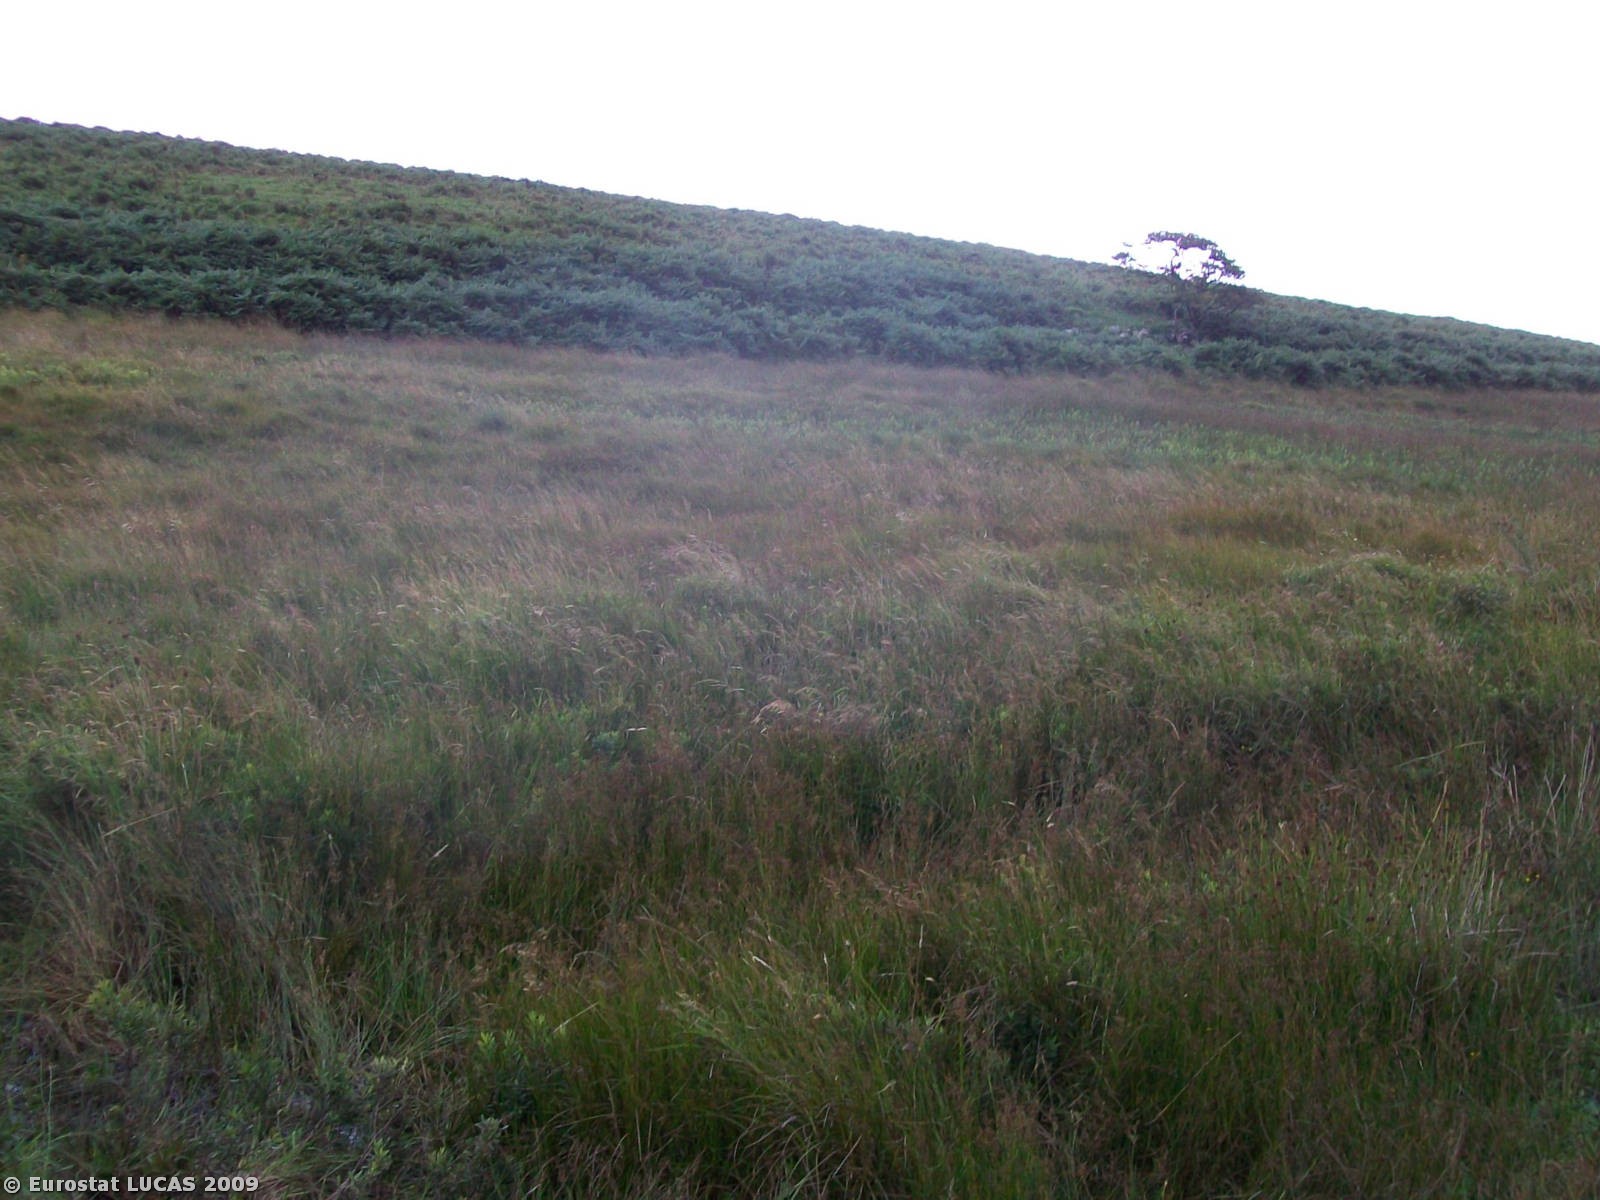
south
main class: Grassland
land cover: Grassland without tree/shrub cover
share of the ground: > 75 %
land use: Agriculture (excluding fallow land and kitchen gardens)
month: August
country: GB
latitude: 54.9070
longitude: -4.7533
